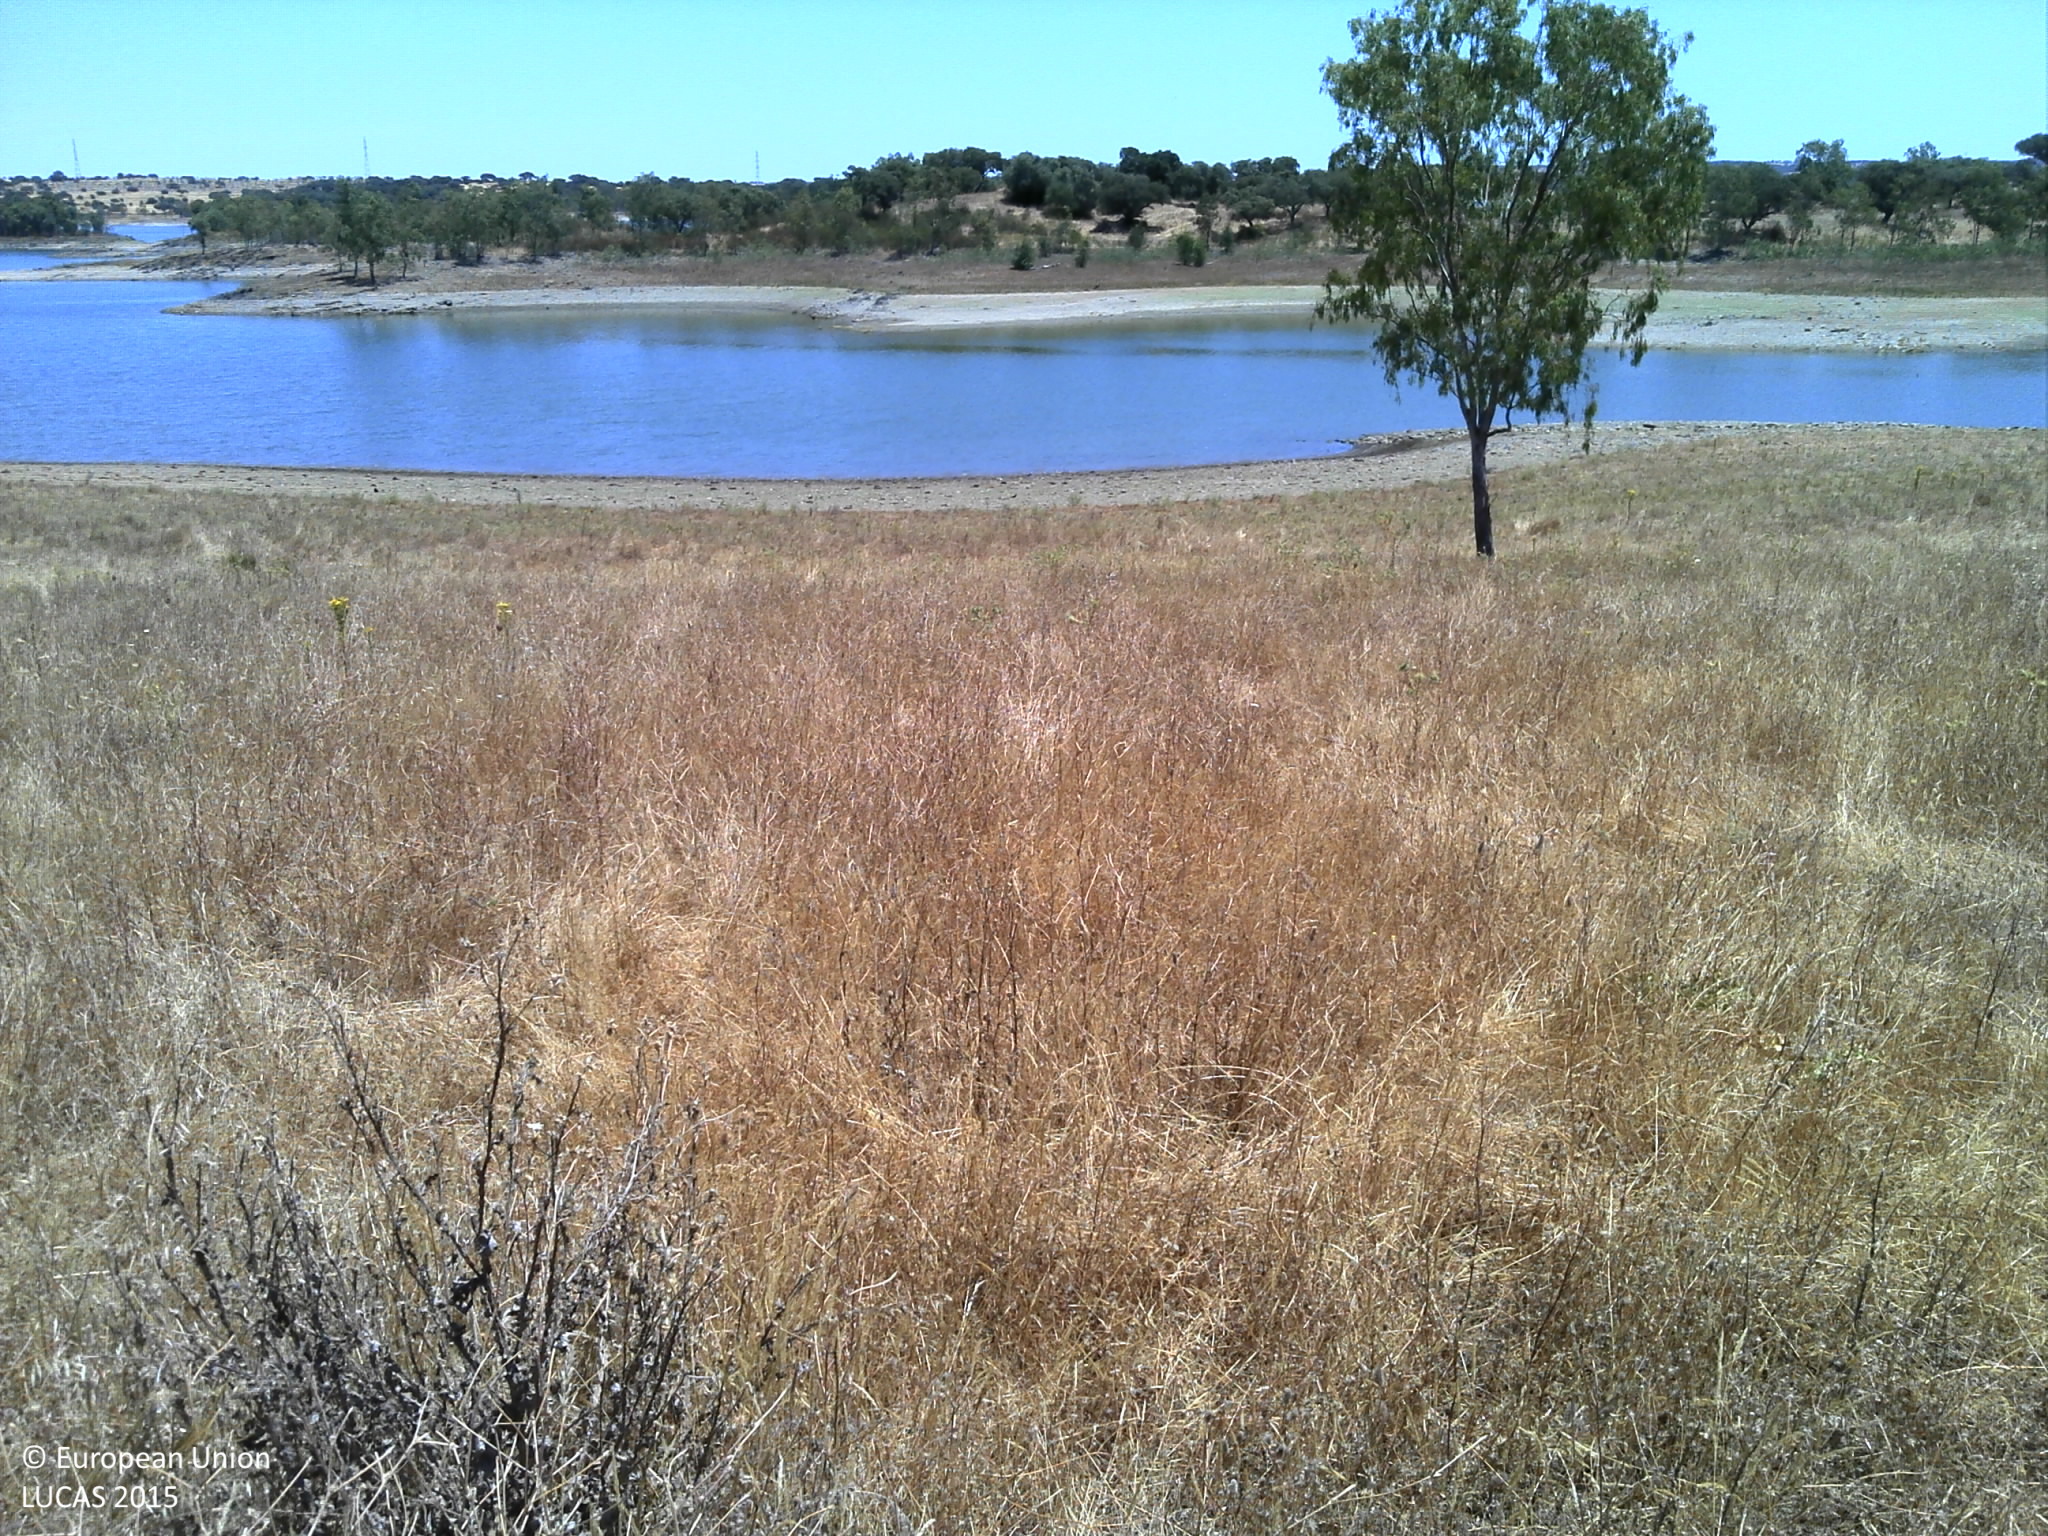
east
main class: Grassland
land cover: Grassland with sparse tree/shrub cover
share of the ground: 50 - 75 %
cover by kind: herbaceous plants 50 %, consolidated bare surface 45 %, broadleaved forest trees 5 %
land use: Agriculture (excluding fallow land and kitchen gardens)
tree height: > 5 m
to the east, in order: Grassland with sparse tree/shrub cover; Grassland without tree/shrub cover; Ponds and wetlands
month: July
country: PT
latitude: 37.7180
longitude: -8.2852
